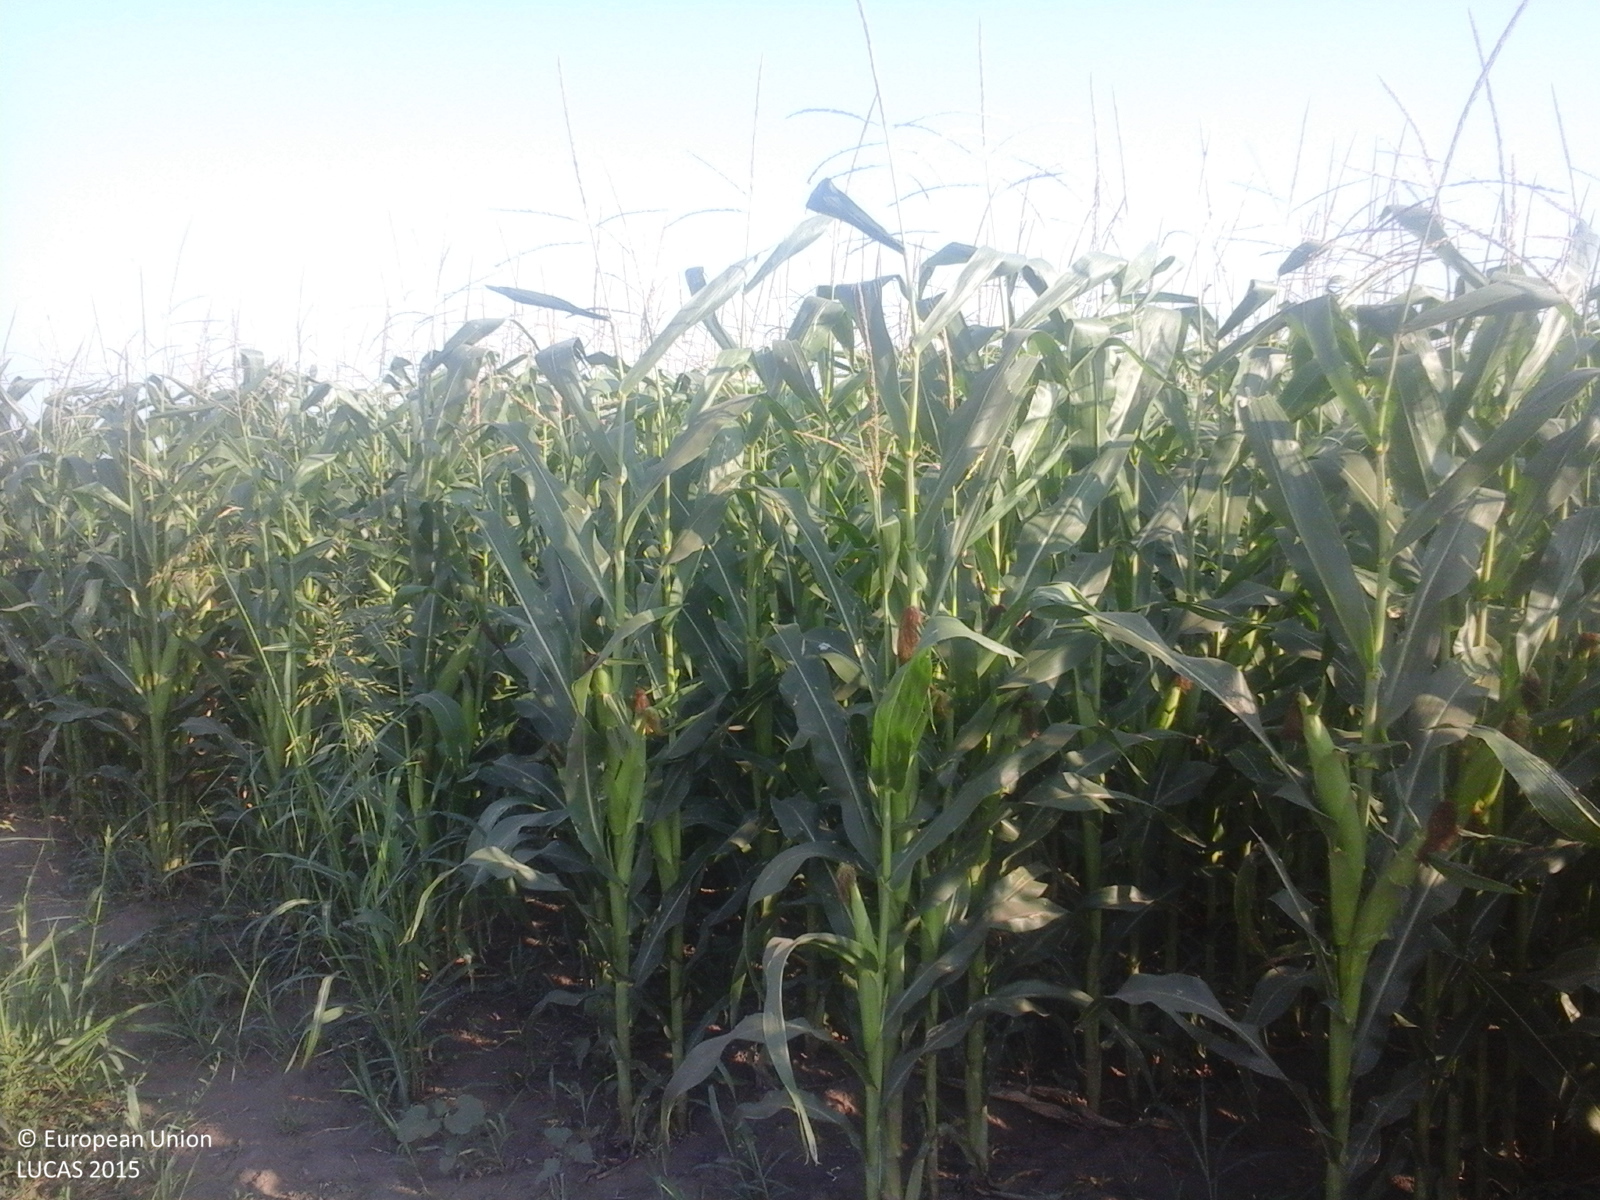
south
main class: Cropland
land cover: Maize
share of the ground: > 75 %
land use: Agriculture (excluding fallow land and kitchen gardens)
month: July
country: RO
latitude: 44.8626
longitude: 27.5760
